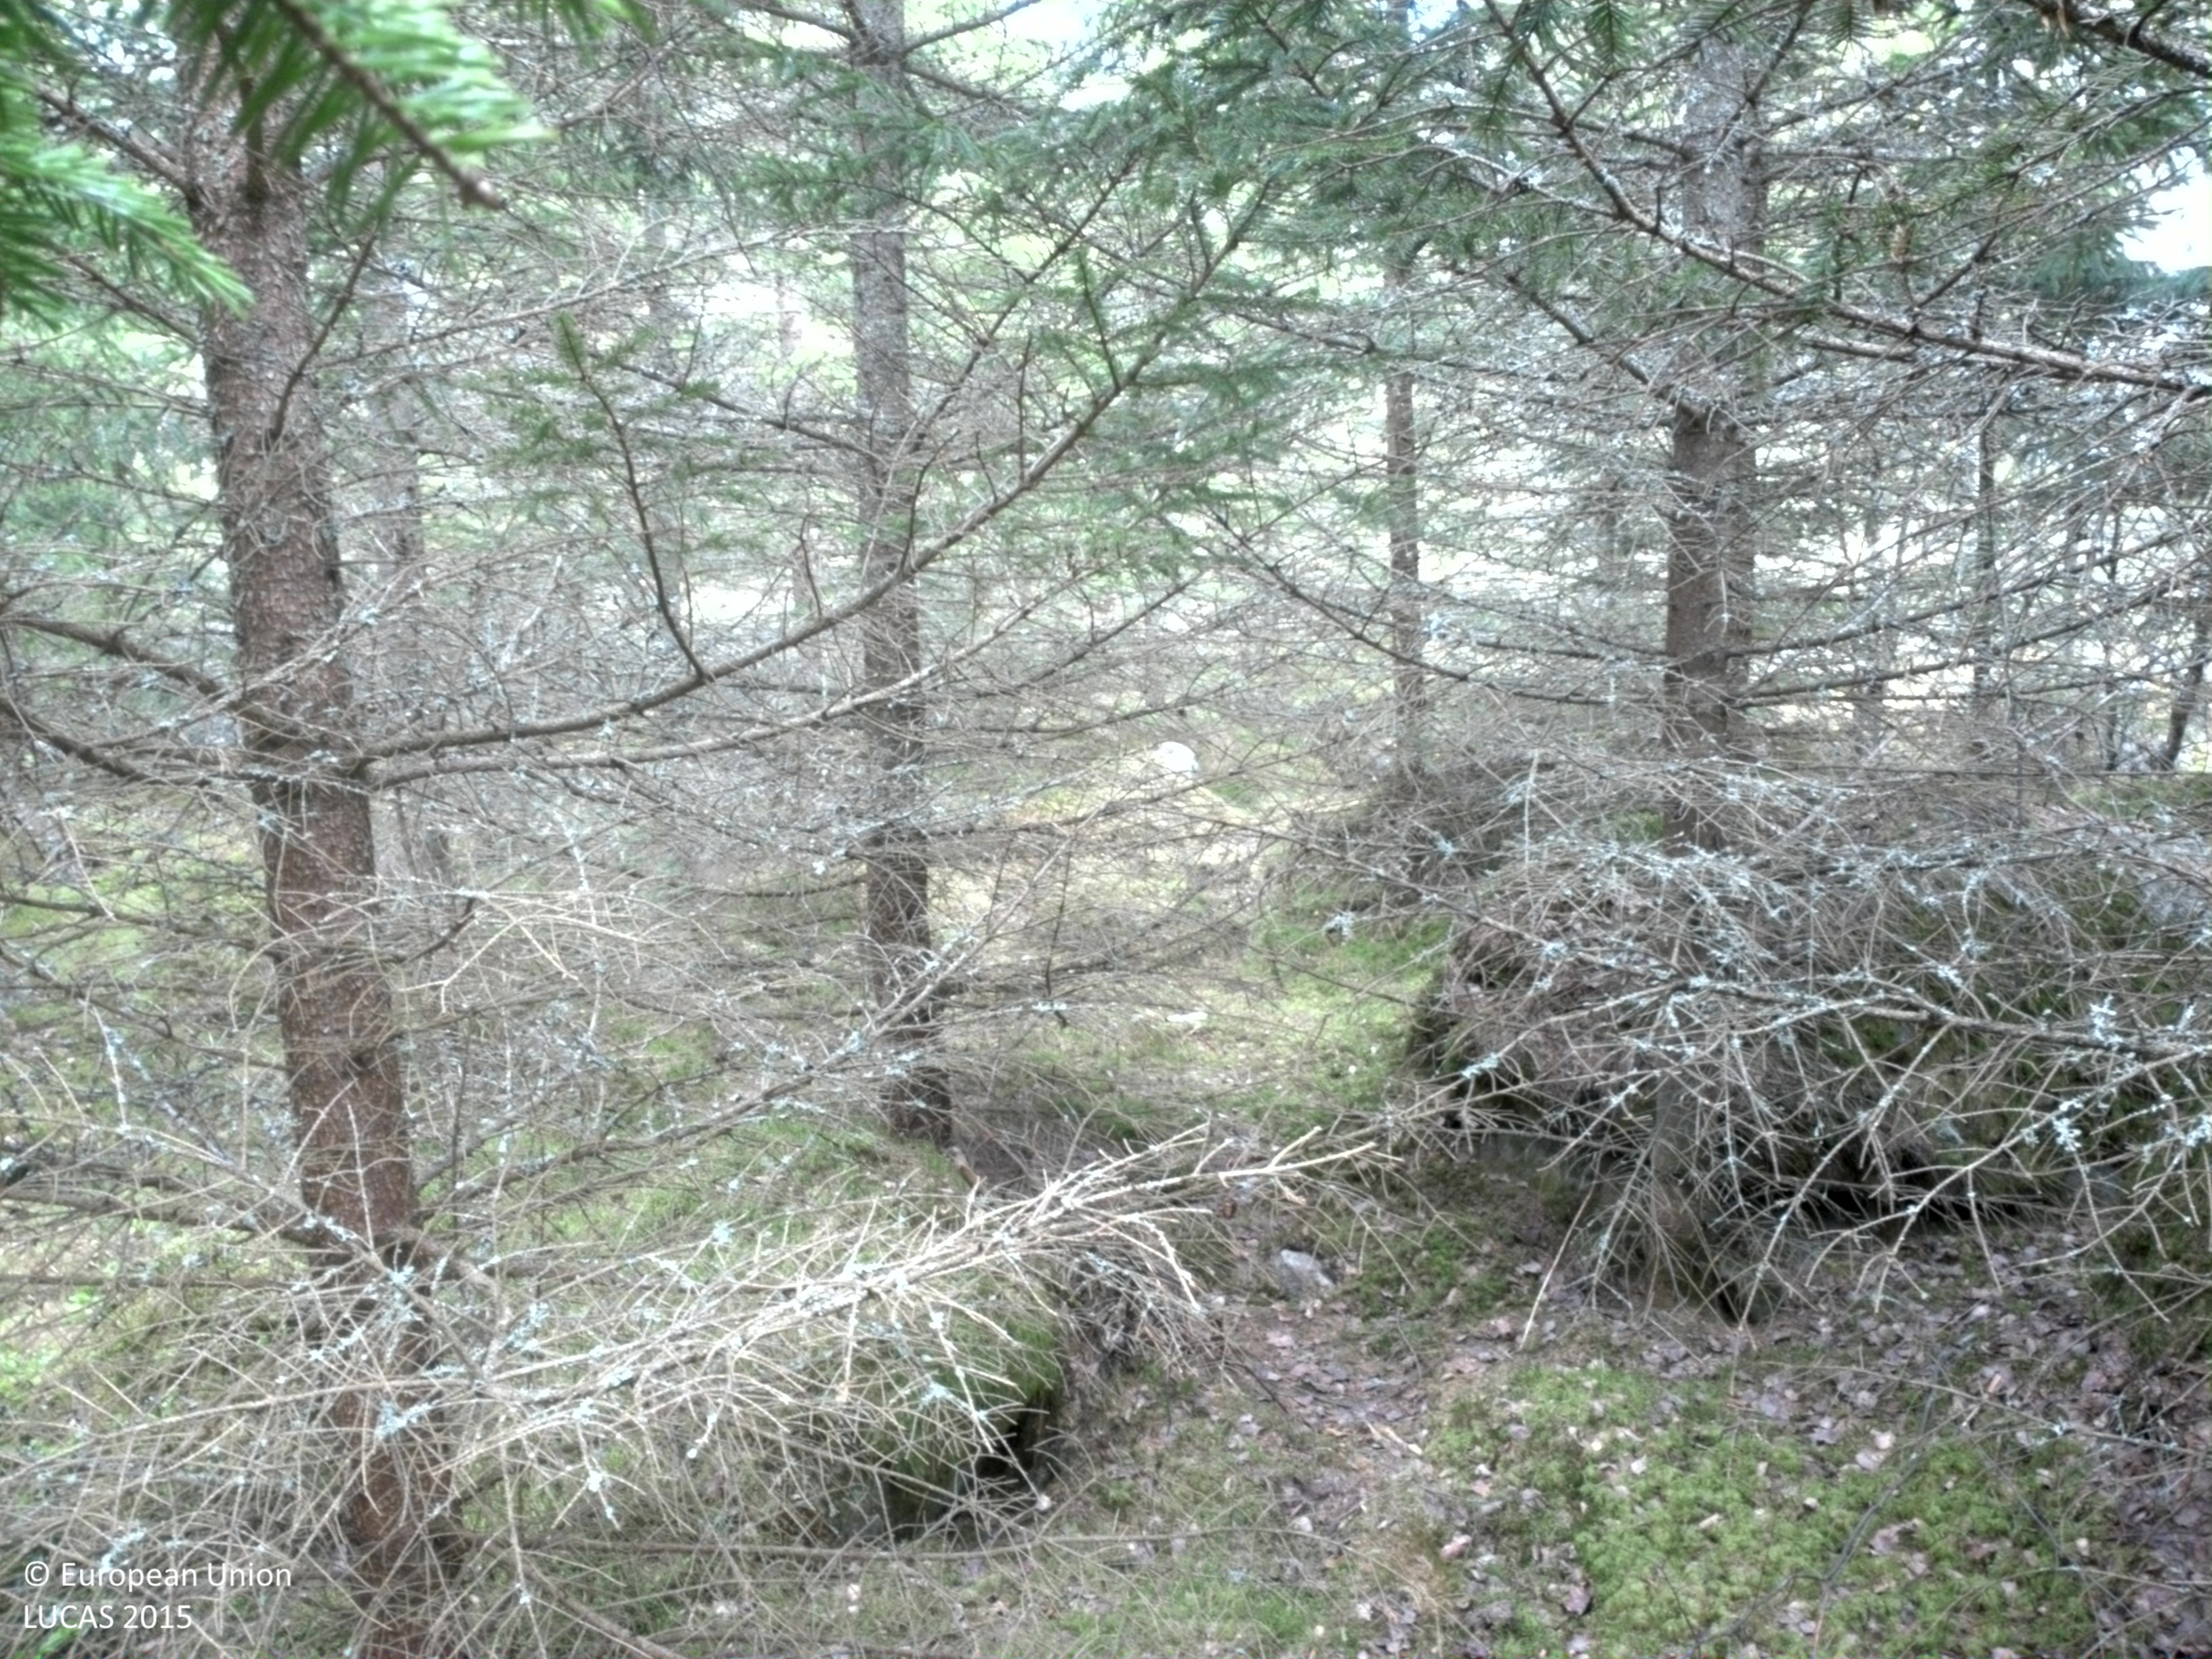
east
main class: Woodland
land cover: Spruce dominated coniferous woodland
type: boreal forest
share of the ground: > 75 %
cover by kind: coniferous forest trees 85 %, lichens and mosses 10 %, broadleaved forest trees 5 %
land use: Forestry
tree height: > 5 m
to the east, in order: Spruce dominated coniferous woodland; Pine dominated mixed woodland; Pine dominated coniferous woodland; Spruce dominated mixed woodland
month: May
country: SE
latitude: 56.6961
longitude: 15.1745
